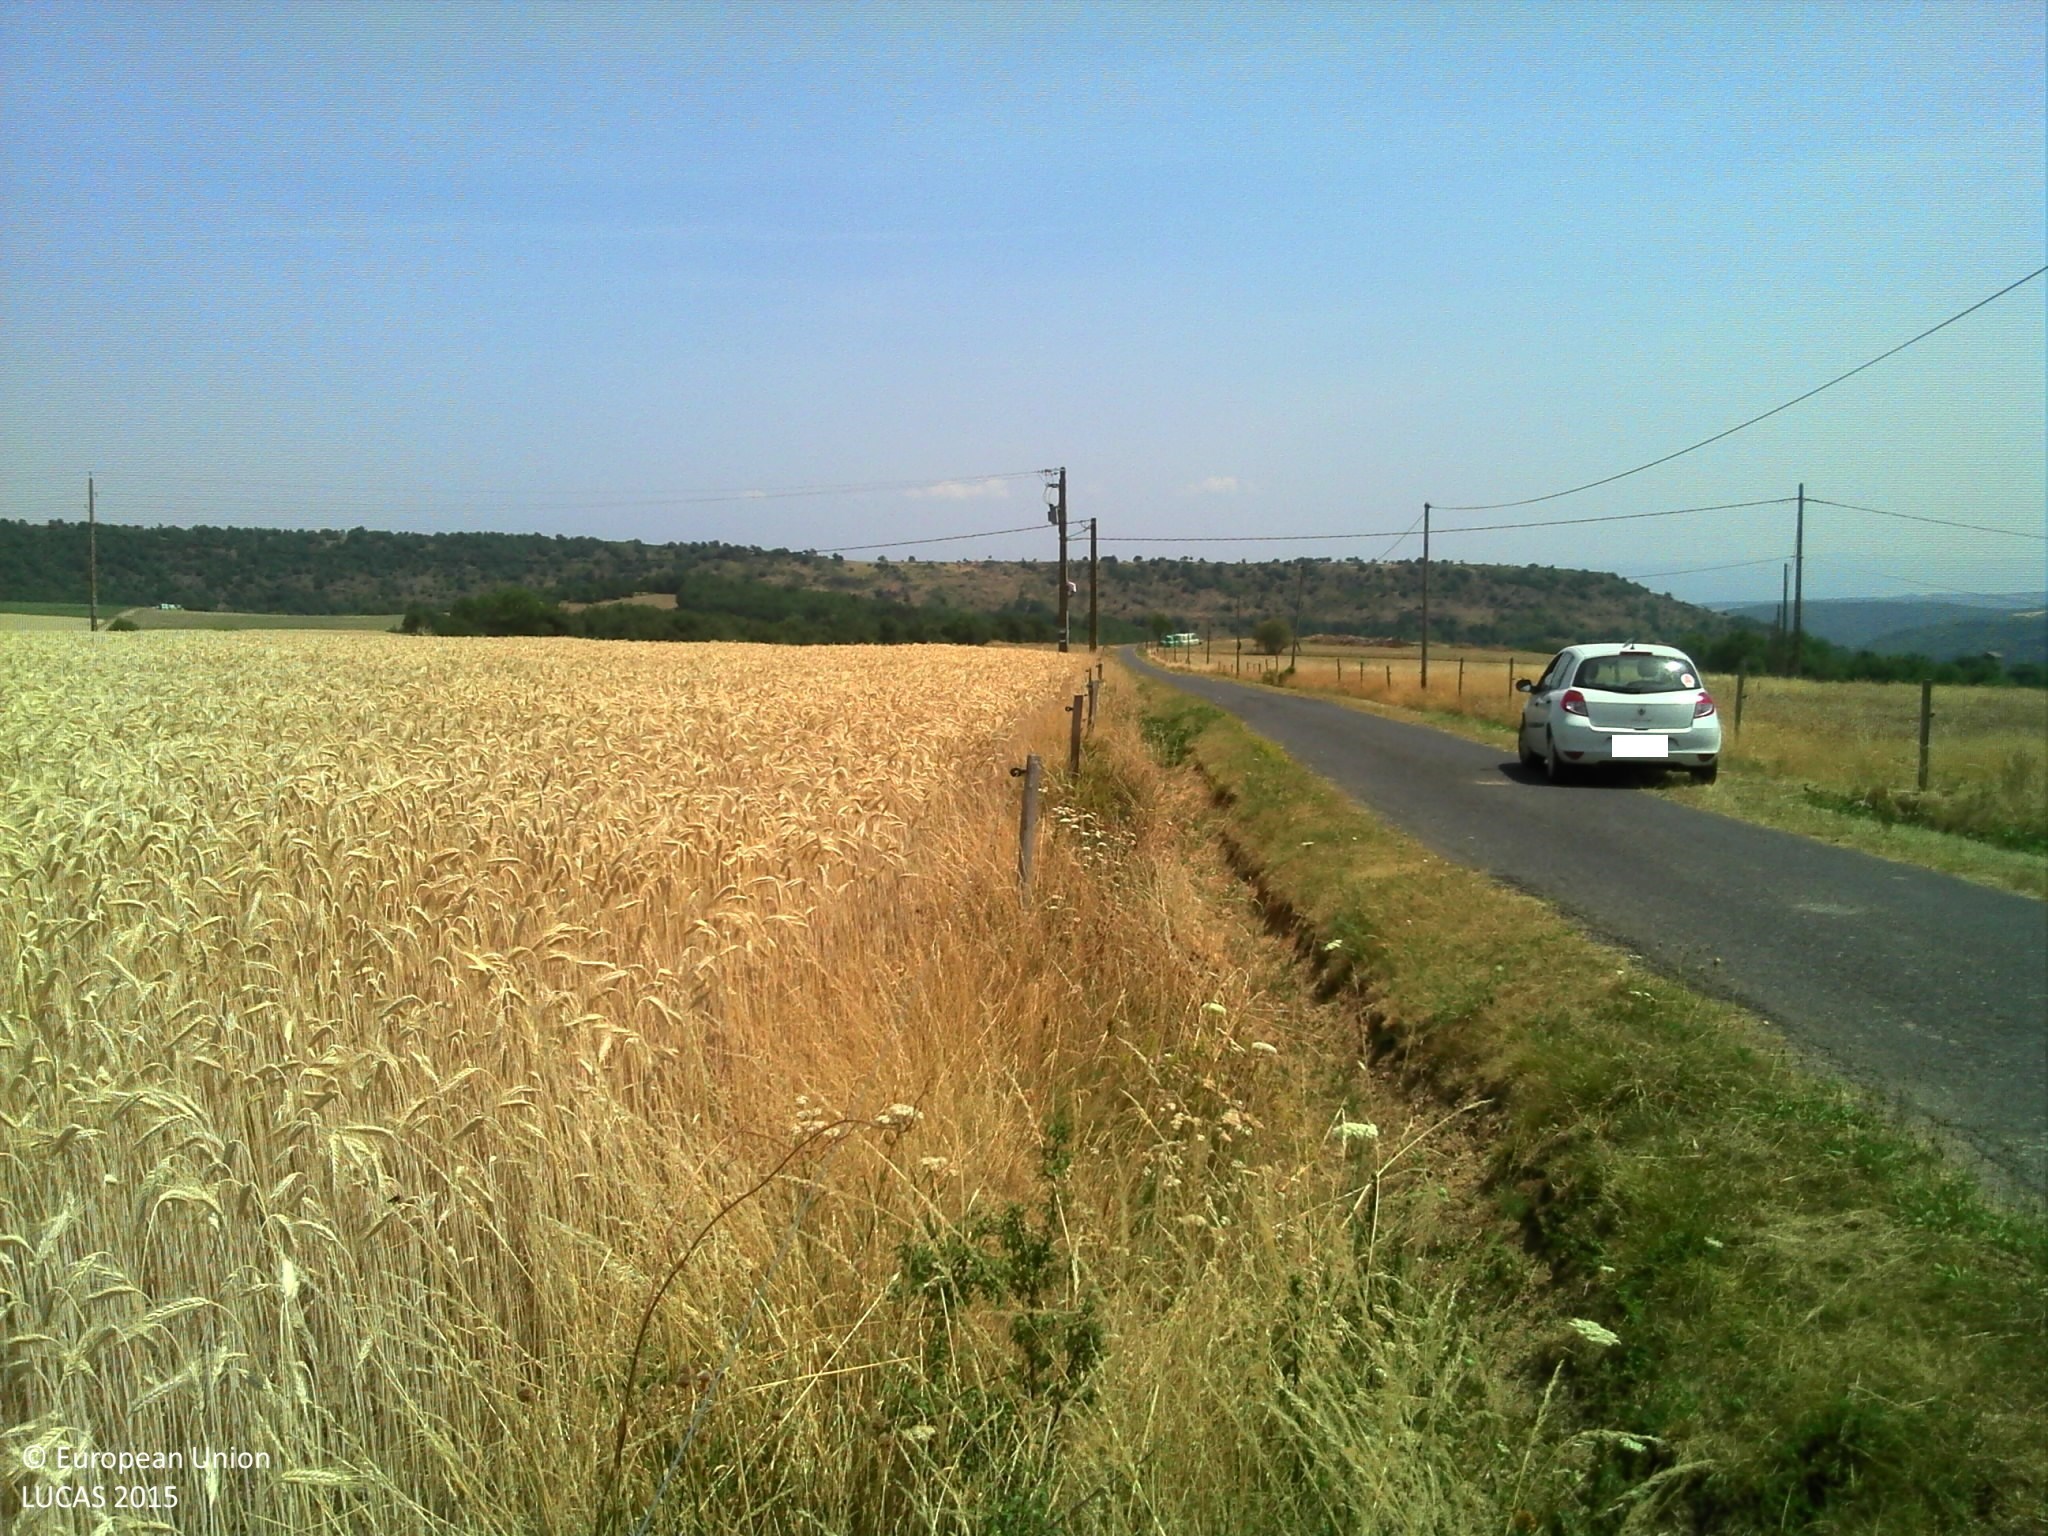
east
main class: Cropland
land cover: Rye
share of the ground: > 75 %
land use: Agriculture (excluding fallow land and kitchen gardens)
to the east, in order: Rye; Fences; Ditches and canals; Grass margins; Paved roads, cycling and walking lanes; Grass margins; Fences; Electric lines; Ditches and canals; Grassland without tree/shrub cover; Fences; Grassland without tree/shrub cover
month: July
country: FR
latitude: 45.3360
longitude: 3.1489
